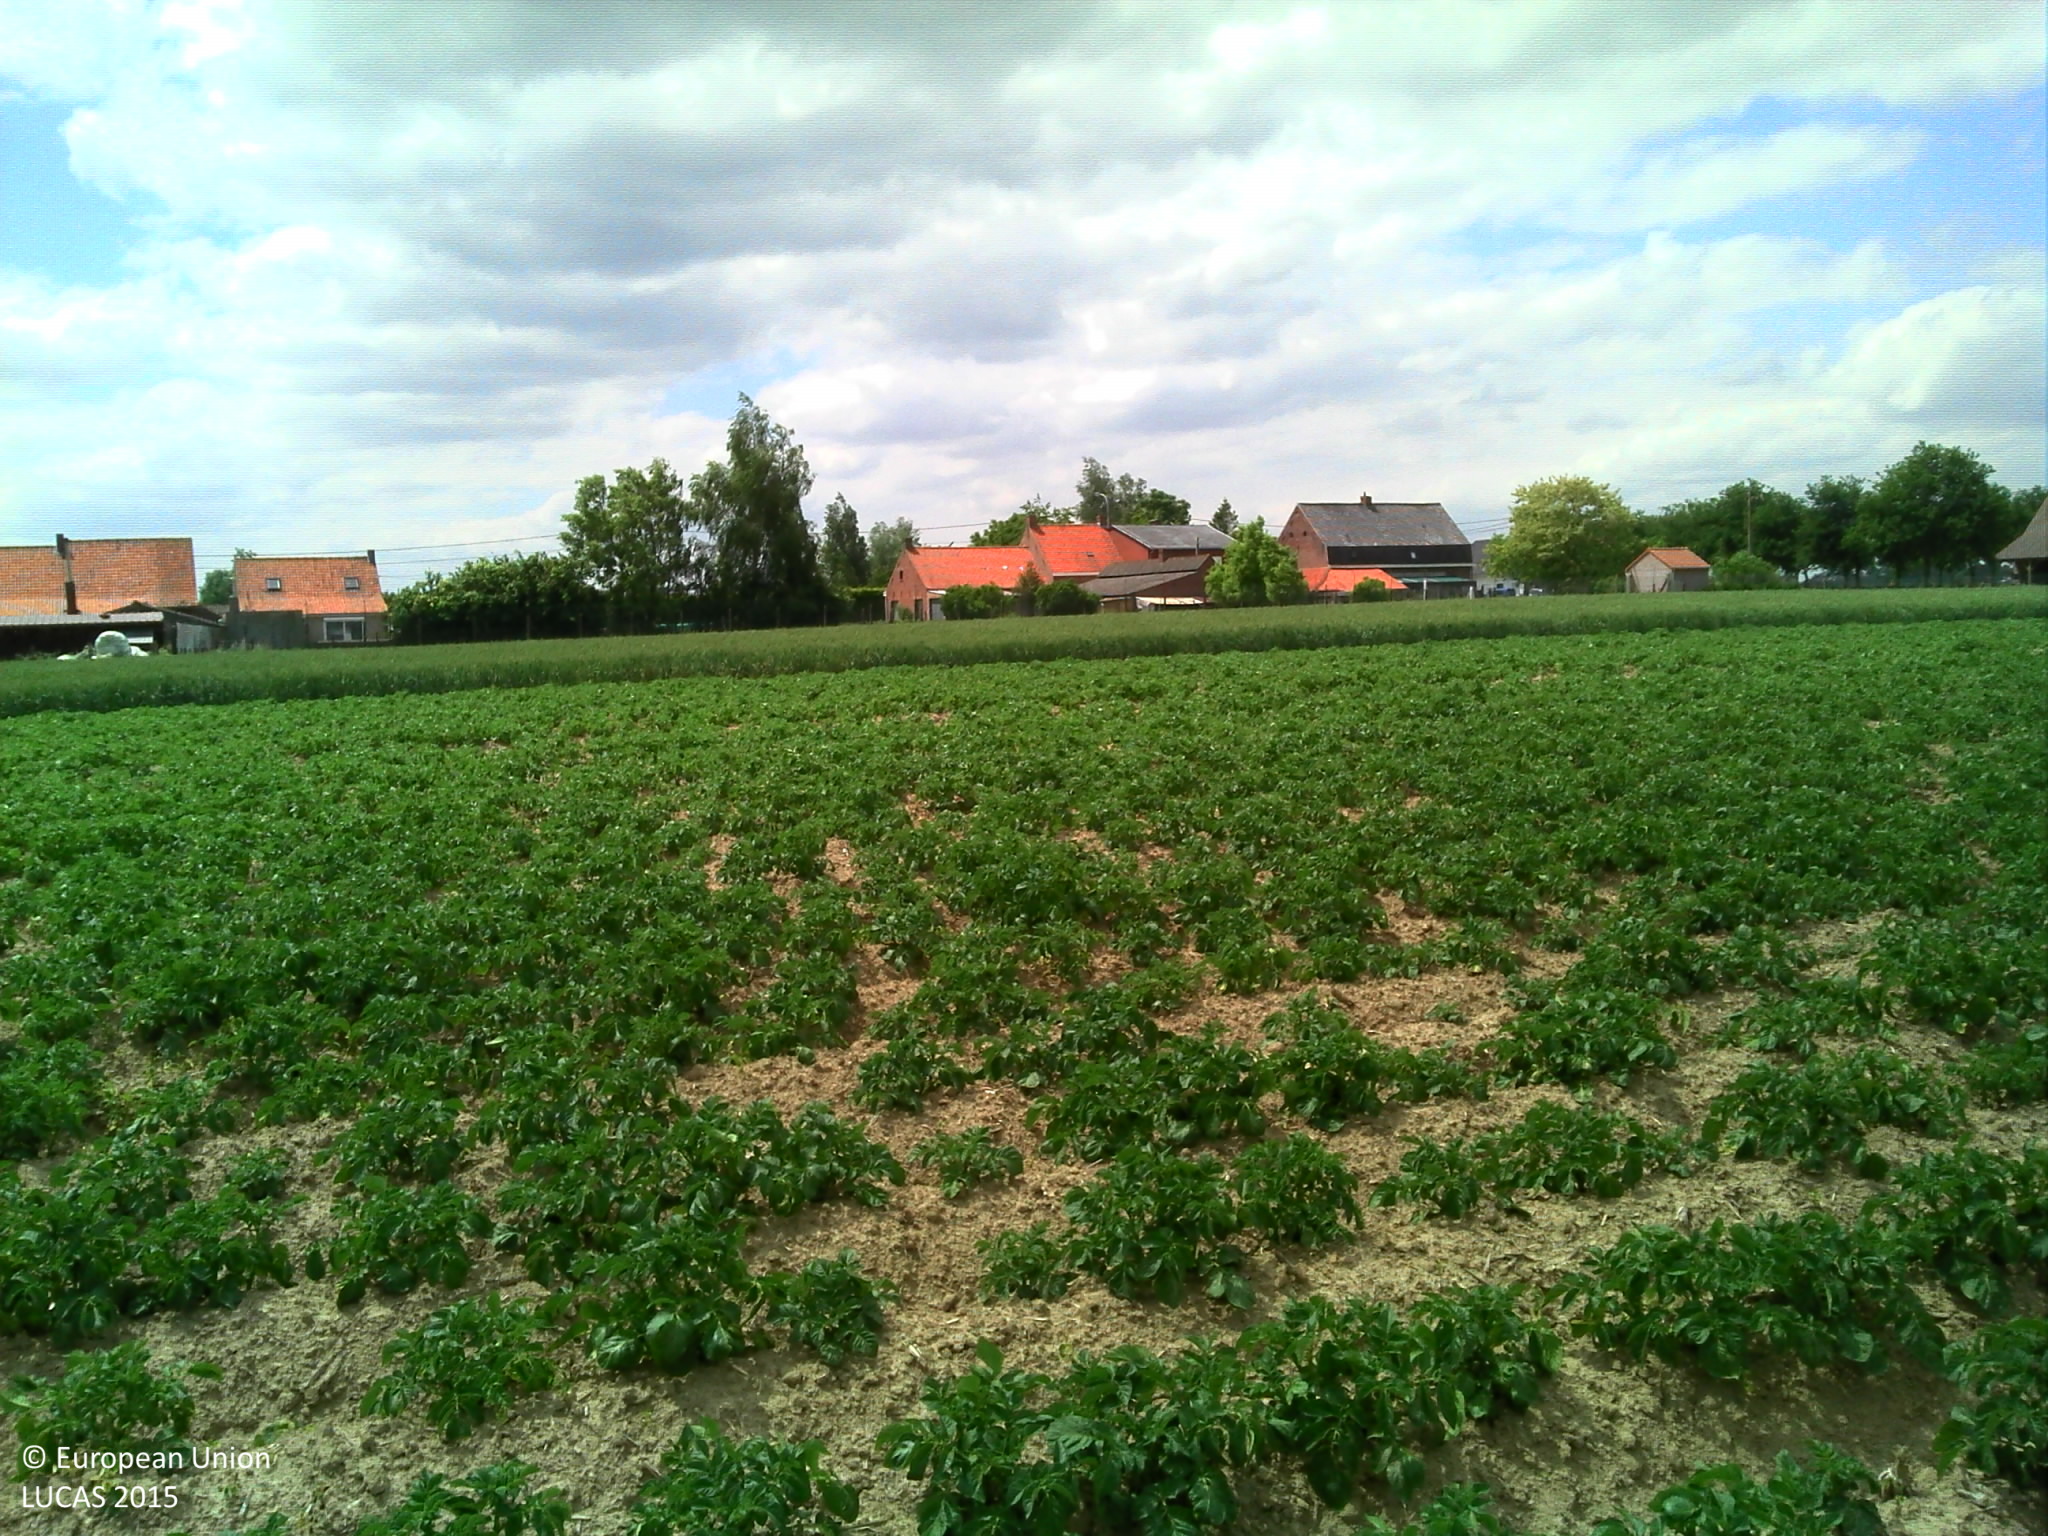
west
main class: Cropland
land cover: Potatoes
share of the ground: 10 - 25 %
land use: Agriculture (excluding fallow land and kitchen gardens)
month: June
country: BE
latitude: 50.8386
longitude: 2.7607
